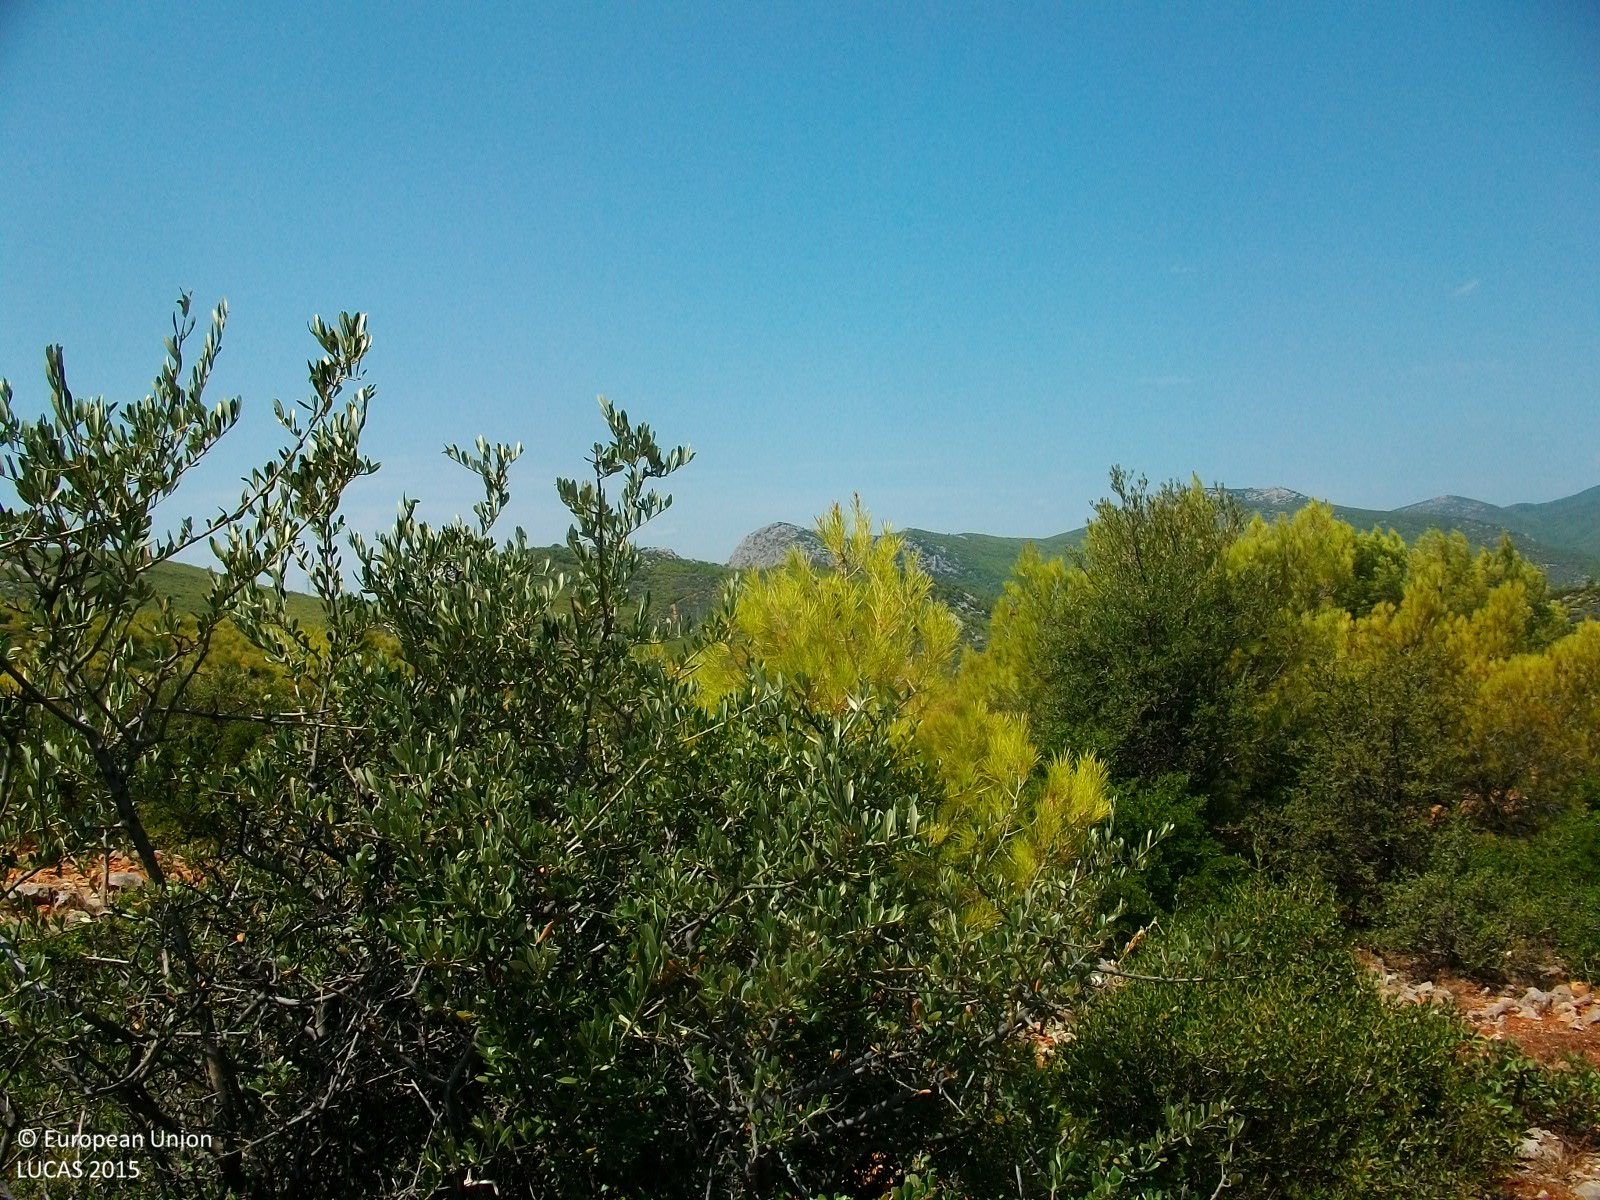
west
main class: Woodland
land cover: Pine dominated coniferous woodland
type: coniferous forest of the mediterranean region
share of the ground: > 75 %
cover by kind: coniferous forest trees 100 %
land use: Semi-natural and natural areas not in use
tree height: < 5 m
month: August
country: GR
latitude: 38.0552
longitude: 23.4378
